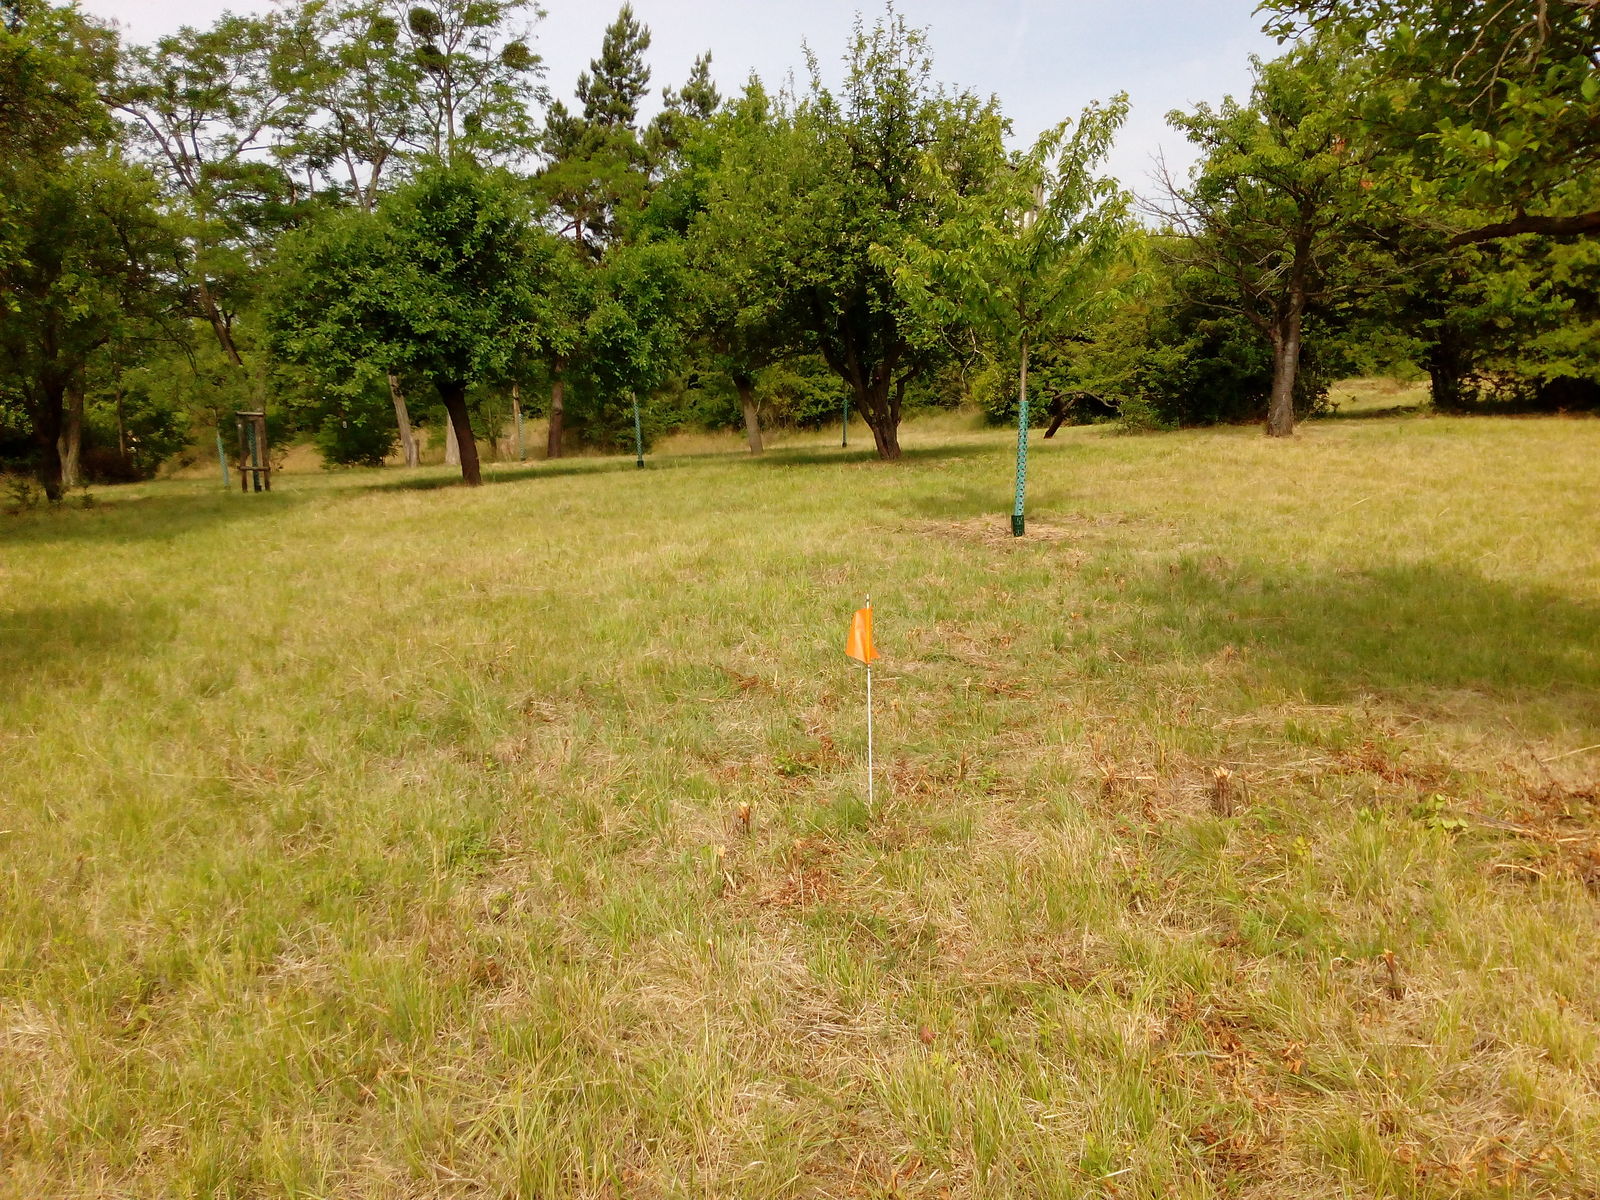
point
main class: Cropland
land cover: Apple fruit
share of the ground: 25 - 50 %
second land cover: Grassland without tree/shrub cover
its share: > 75 %
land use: Agriculture (excluding fallow land and kitchen gardens)
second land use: Amenities, museums, leisure
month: June
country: DE
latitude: 51.3656
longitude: 11.1057
